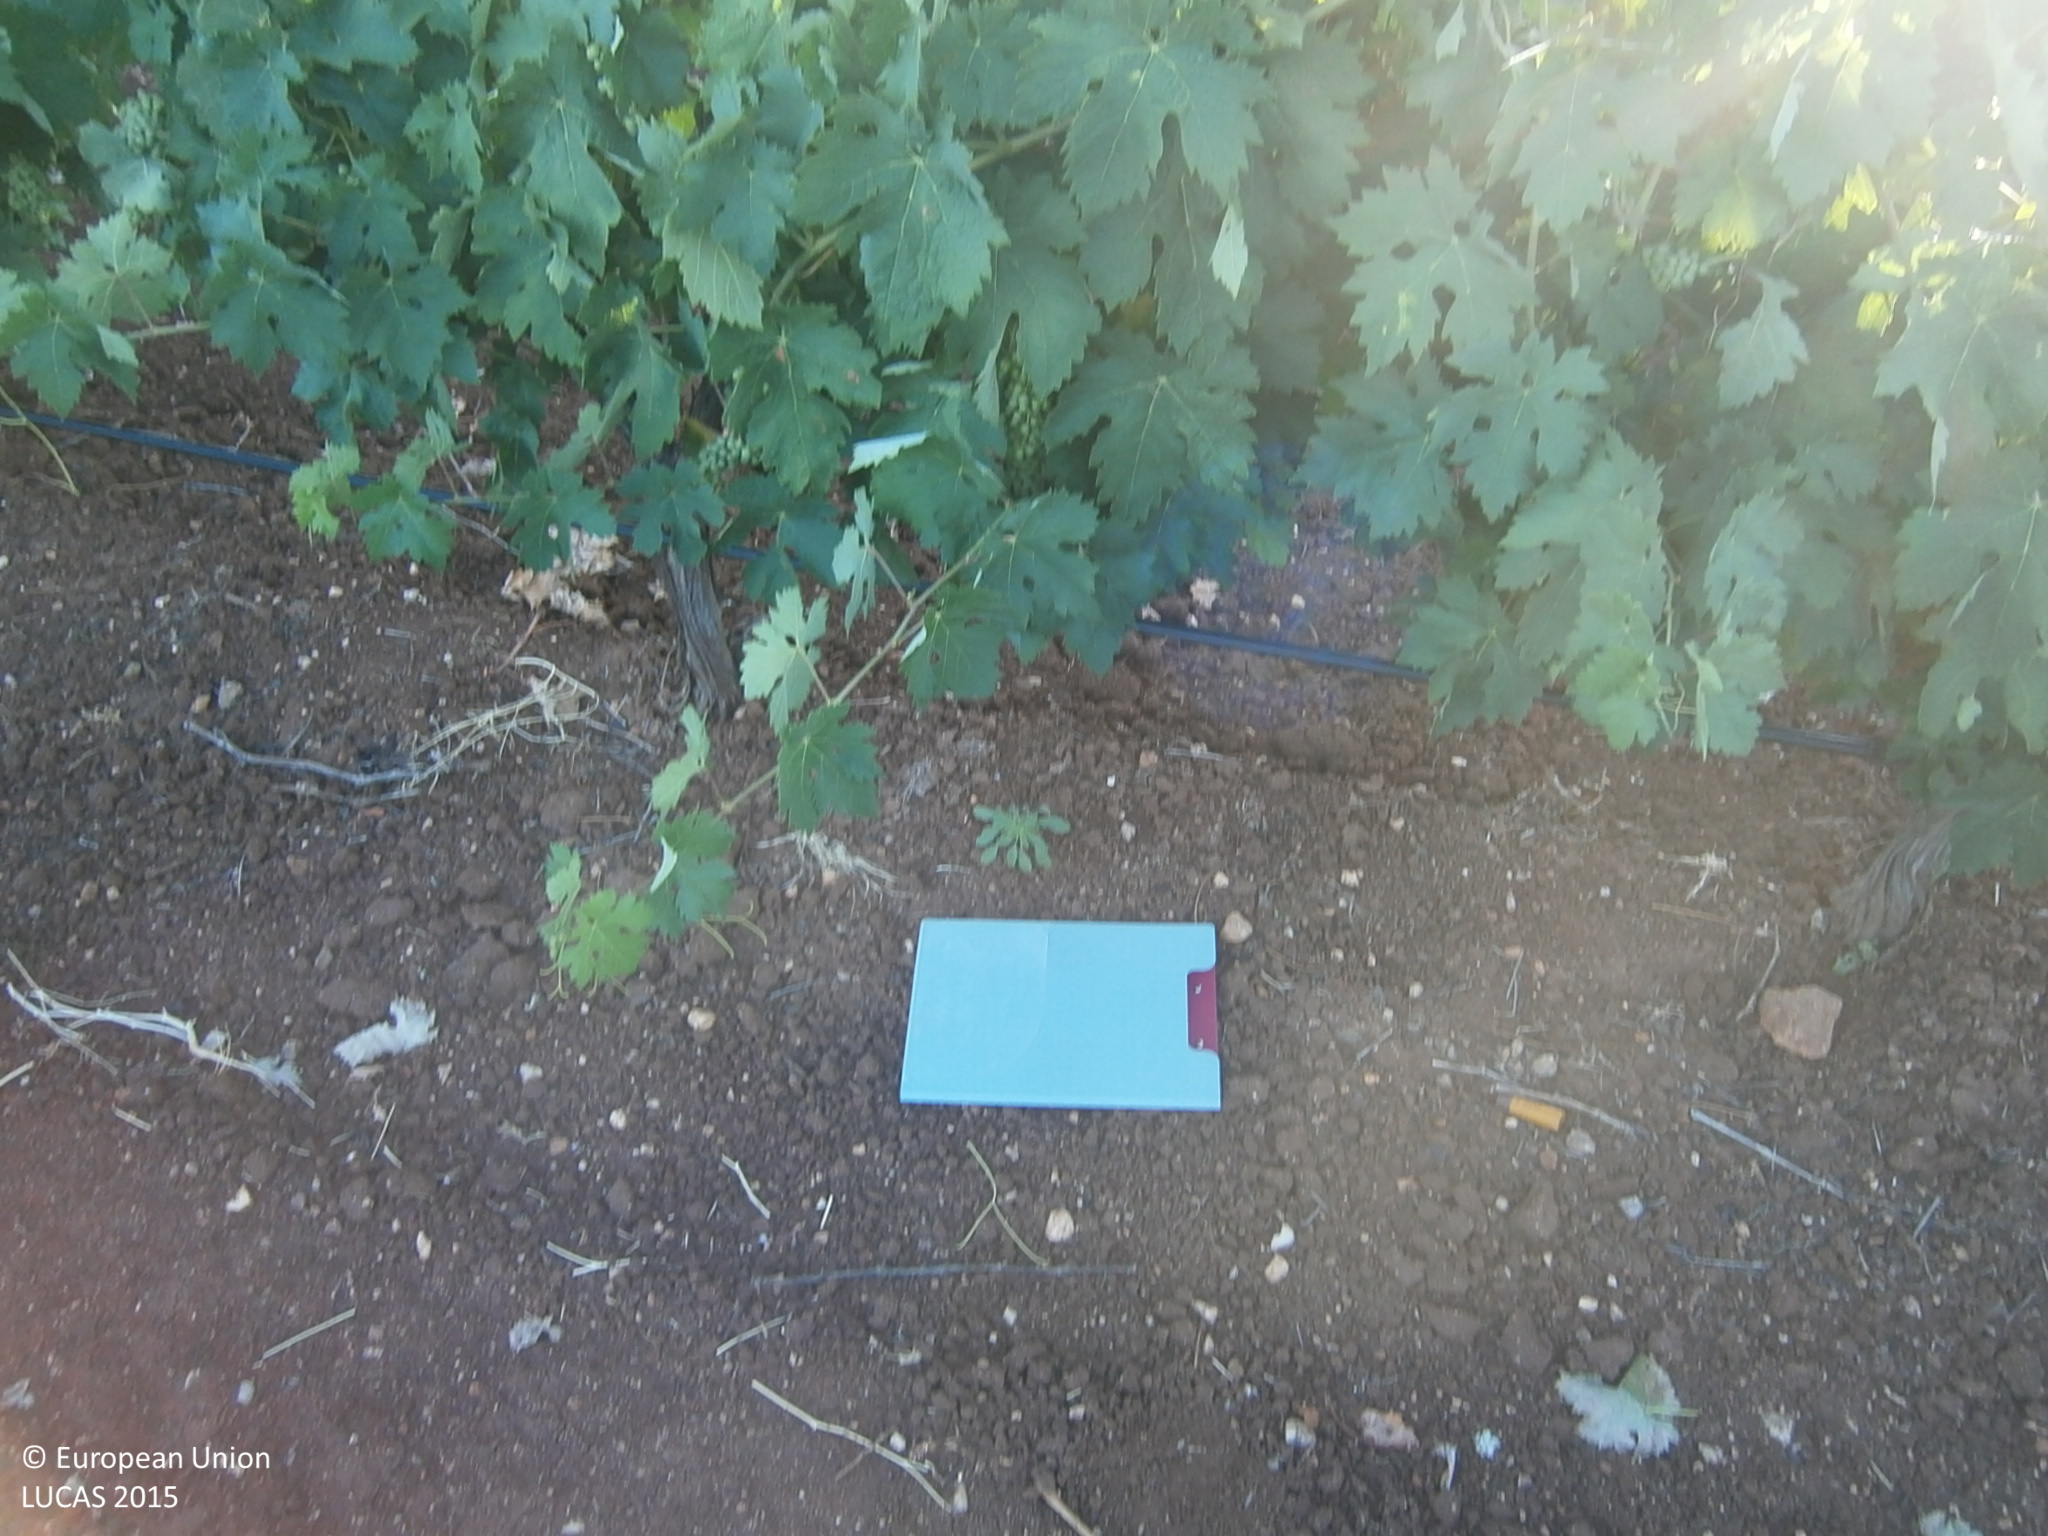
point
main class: Cropland
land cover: Vineyards
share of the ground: 25 - 50 %
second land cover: Other bare soil
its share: > 75 %
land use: Agriculture (excluding fallow land and kitchen gardens)
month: June
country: ES
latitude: 38.7075
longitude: -6.4192
